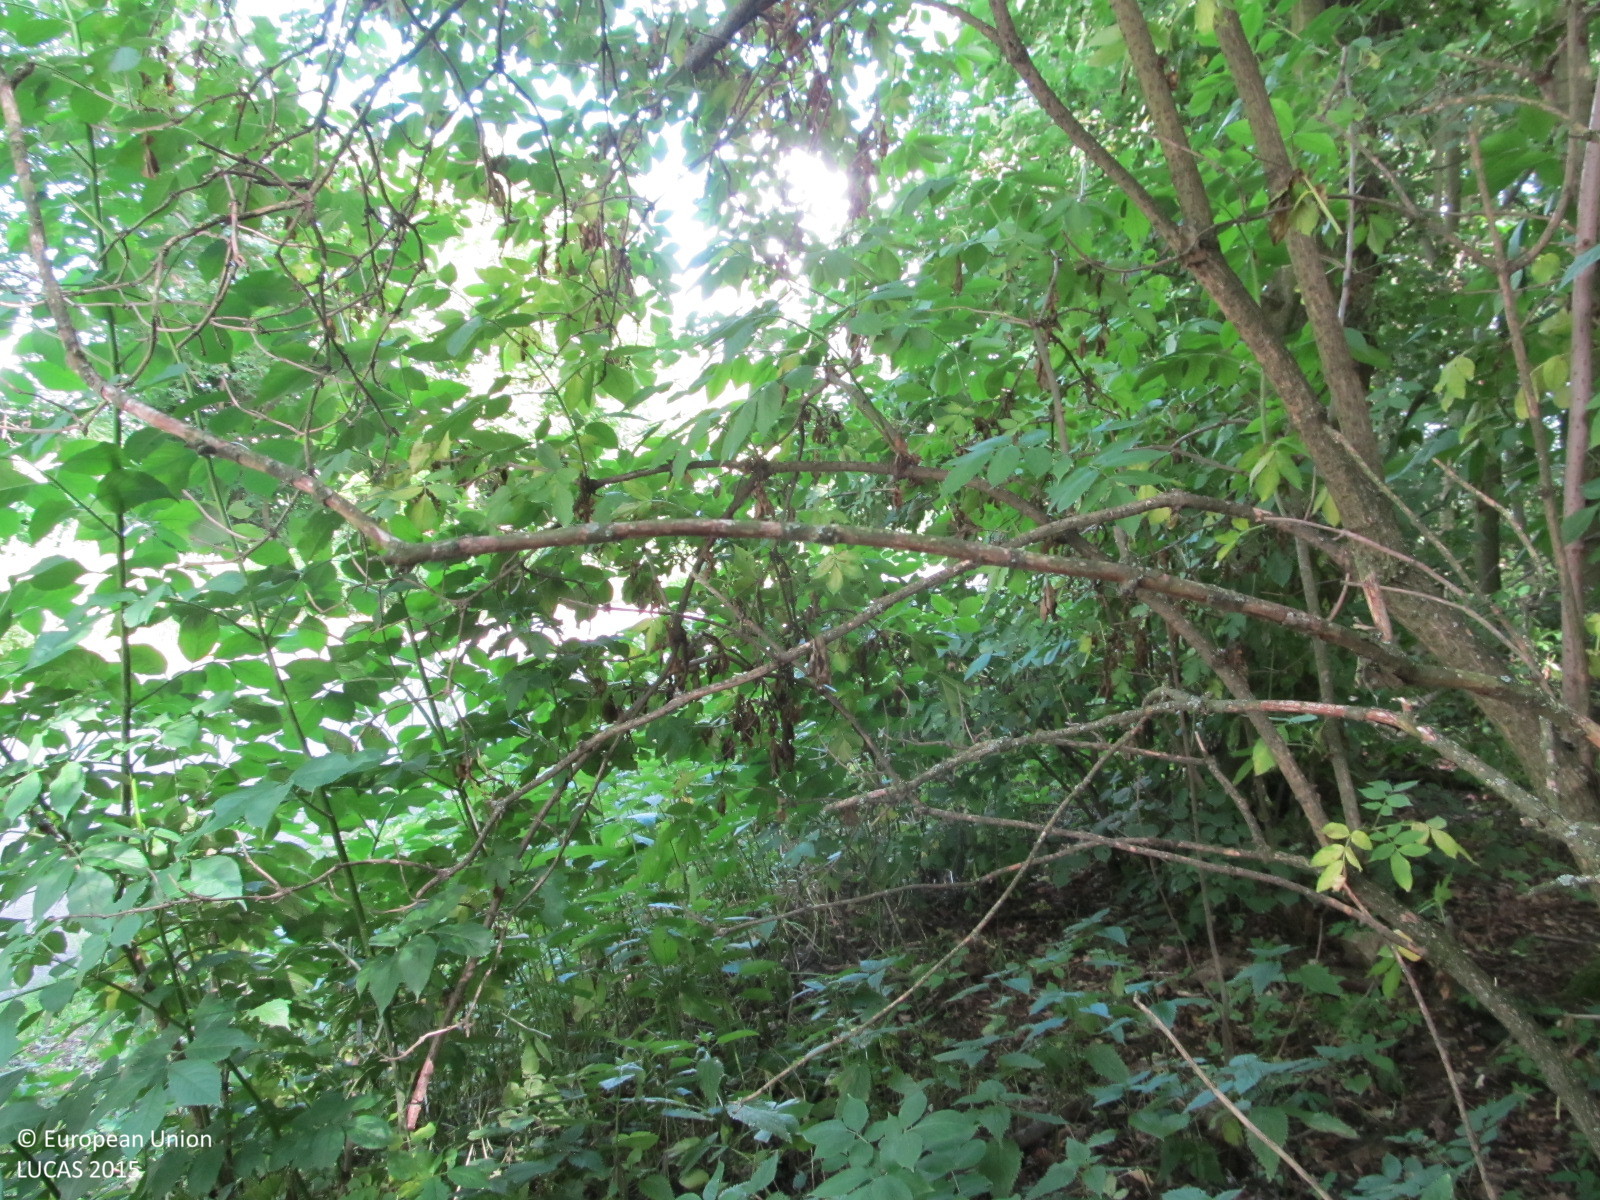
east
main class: Woodland
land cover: Broadleaved woodland
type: hemiboreal forest and nemoral coniferous forest and mixed broadleaved-coniferous forest
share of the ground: > 75 %
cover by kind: broadleaved forest trees 80 %, shrubs 10 %, herbaceous plants 10 %
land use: Forestry
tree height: > 5 m
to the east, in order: Broadleaved woodland; Paved roads, cycling and walking lanes; Grass margins; Ditches and canals; Broadleaved woodland; Maize; Barley
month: June
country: AT
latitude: 48.5571
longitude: 15.8162
